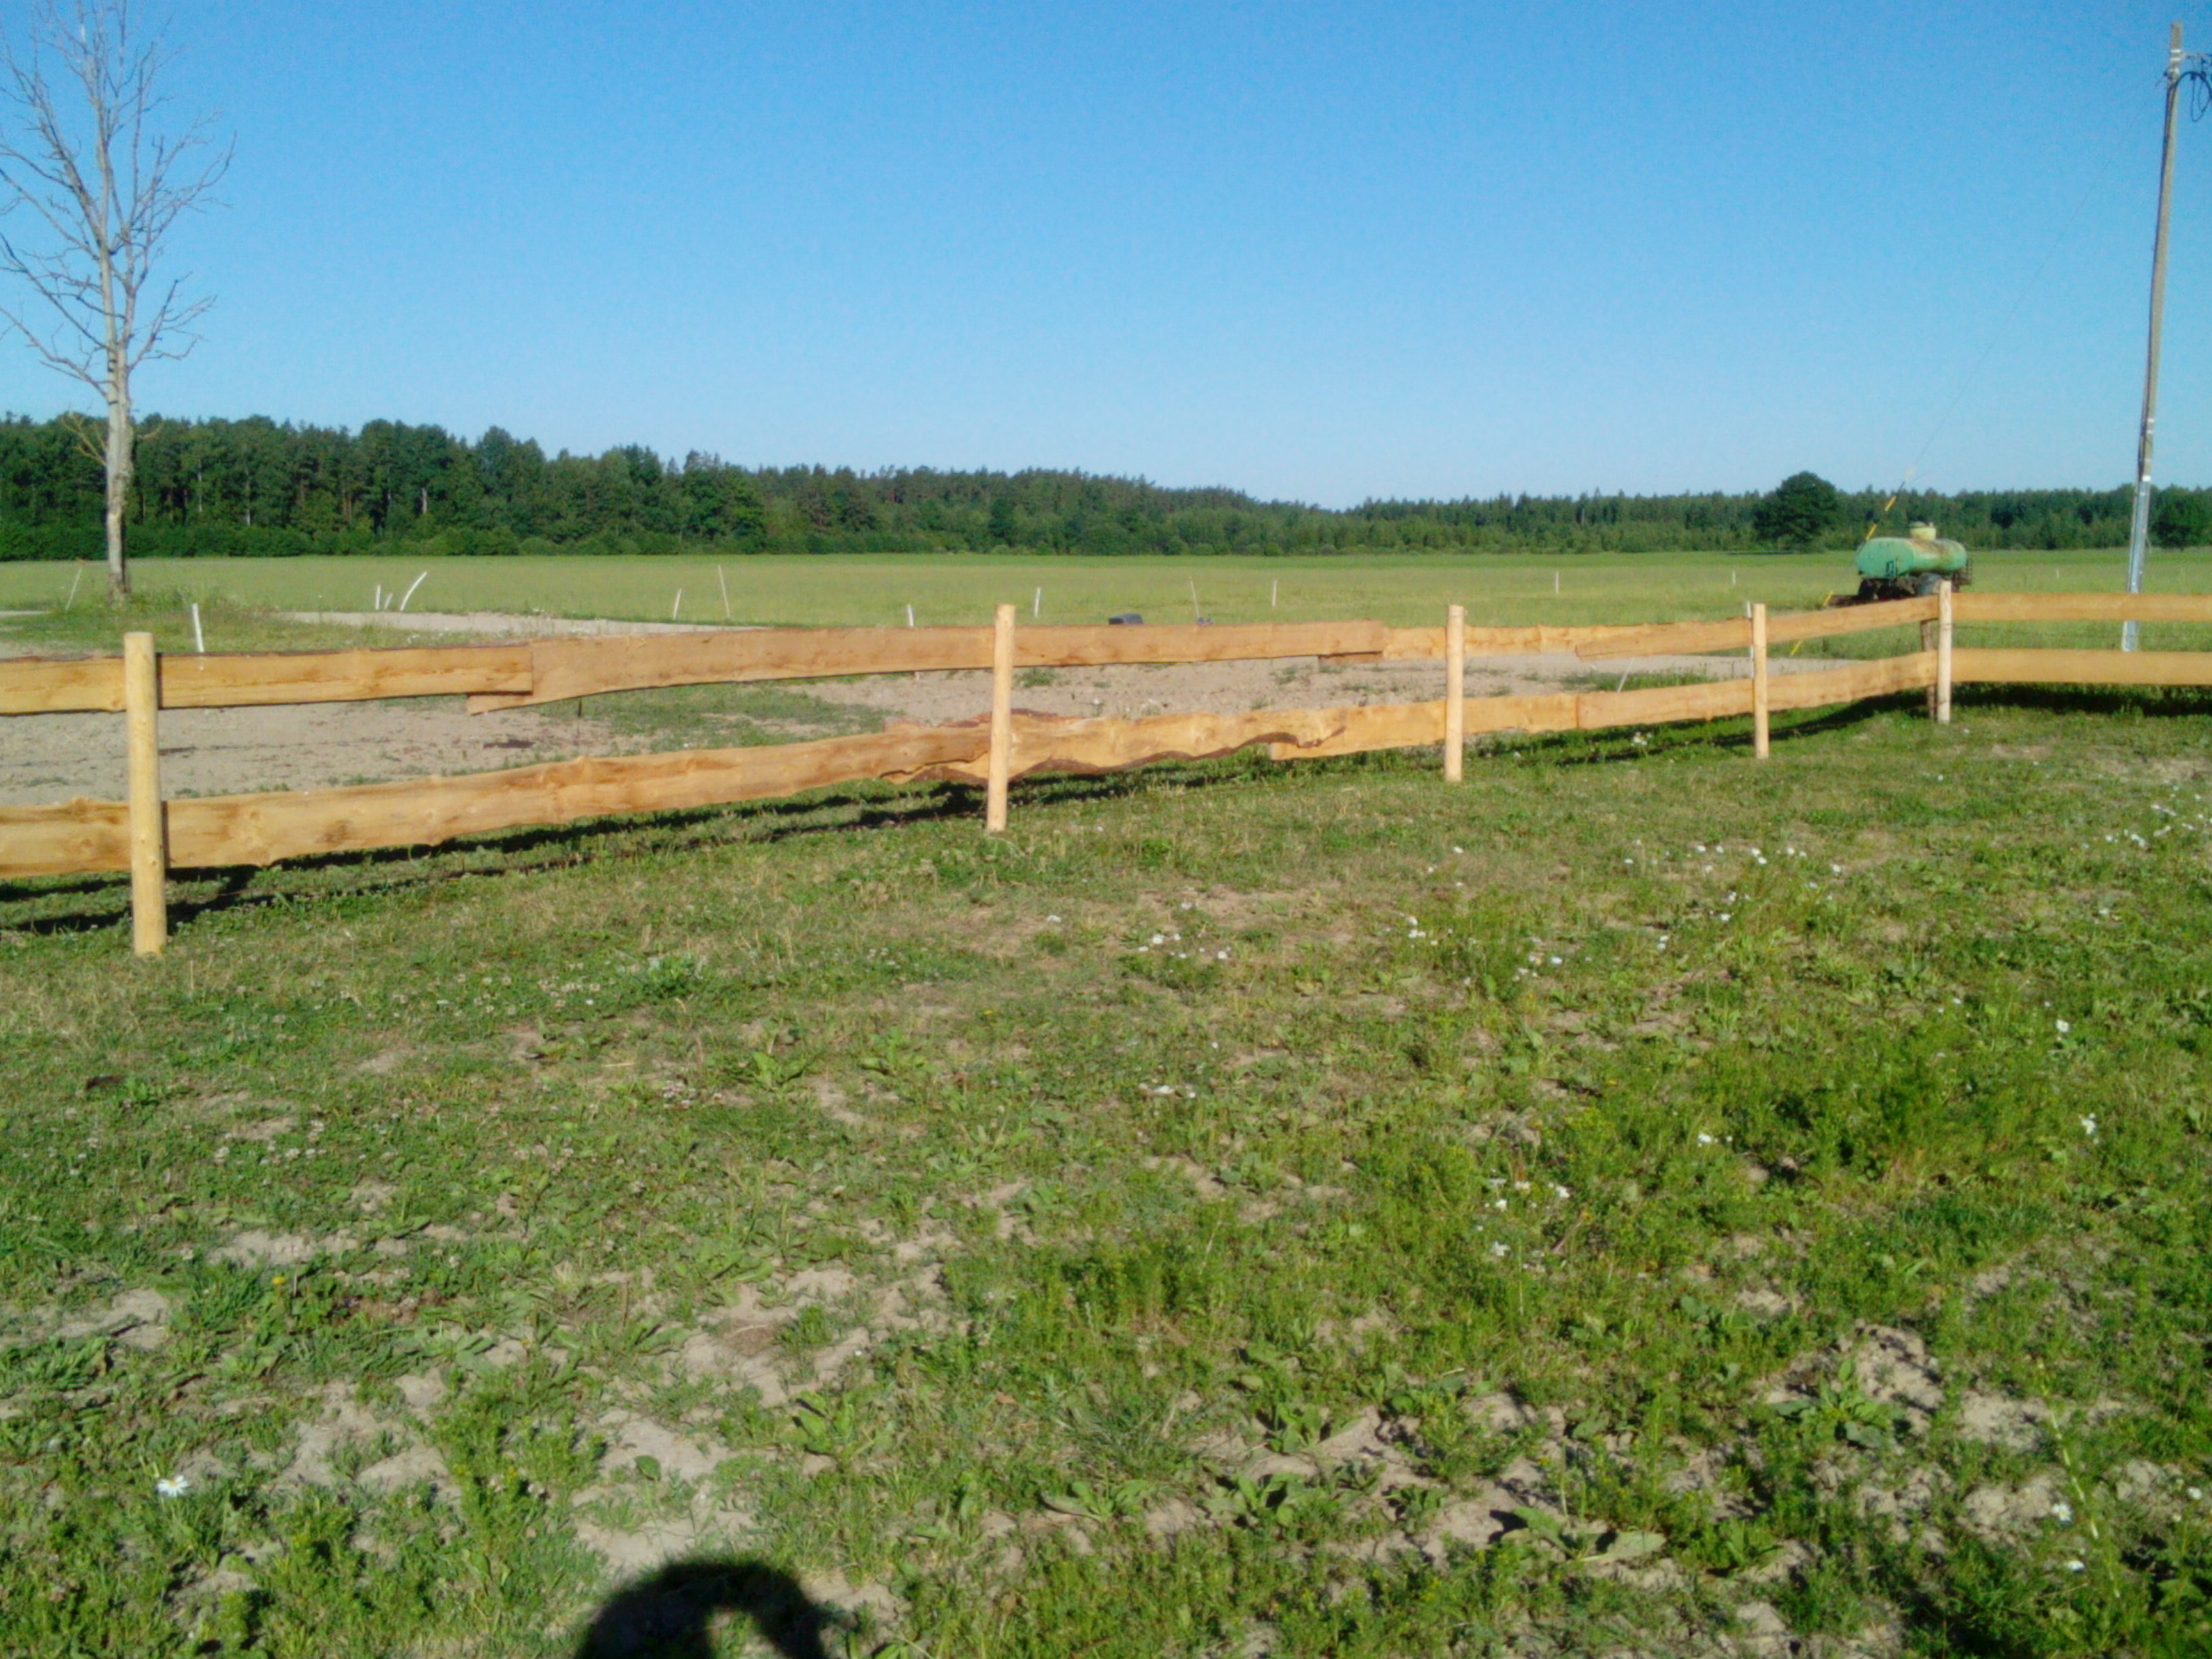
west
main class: Grassland
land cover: Grassland without tree/shrub cover
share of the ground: > 75 %
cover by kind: herbaceous plants 80 %, unconsolidated bare surface 20 %
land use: Agriculture (excluding fallow land and kitchen gardens)
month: July
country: LV
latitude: 56.4258
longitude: 22.1638
